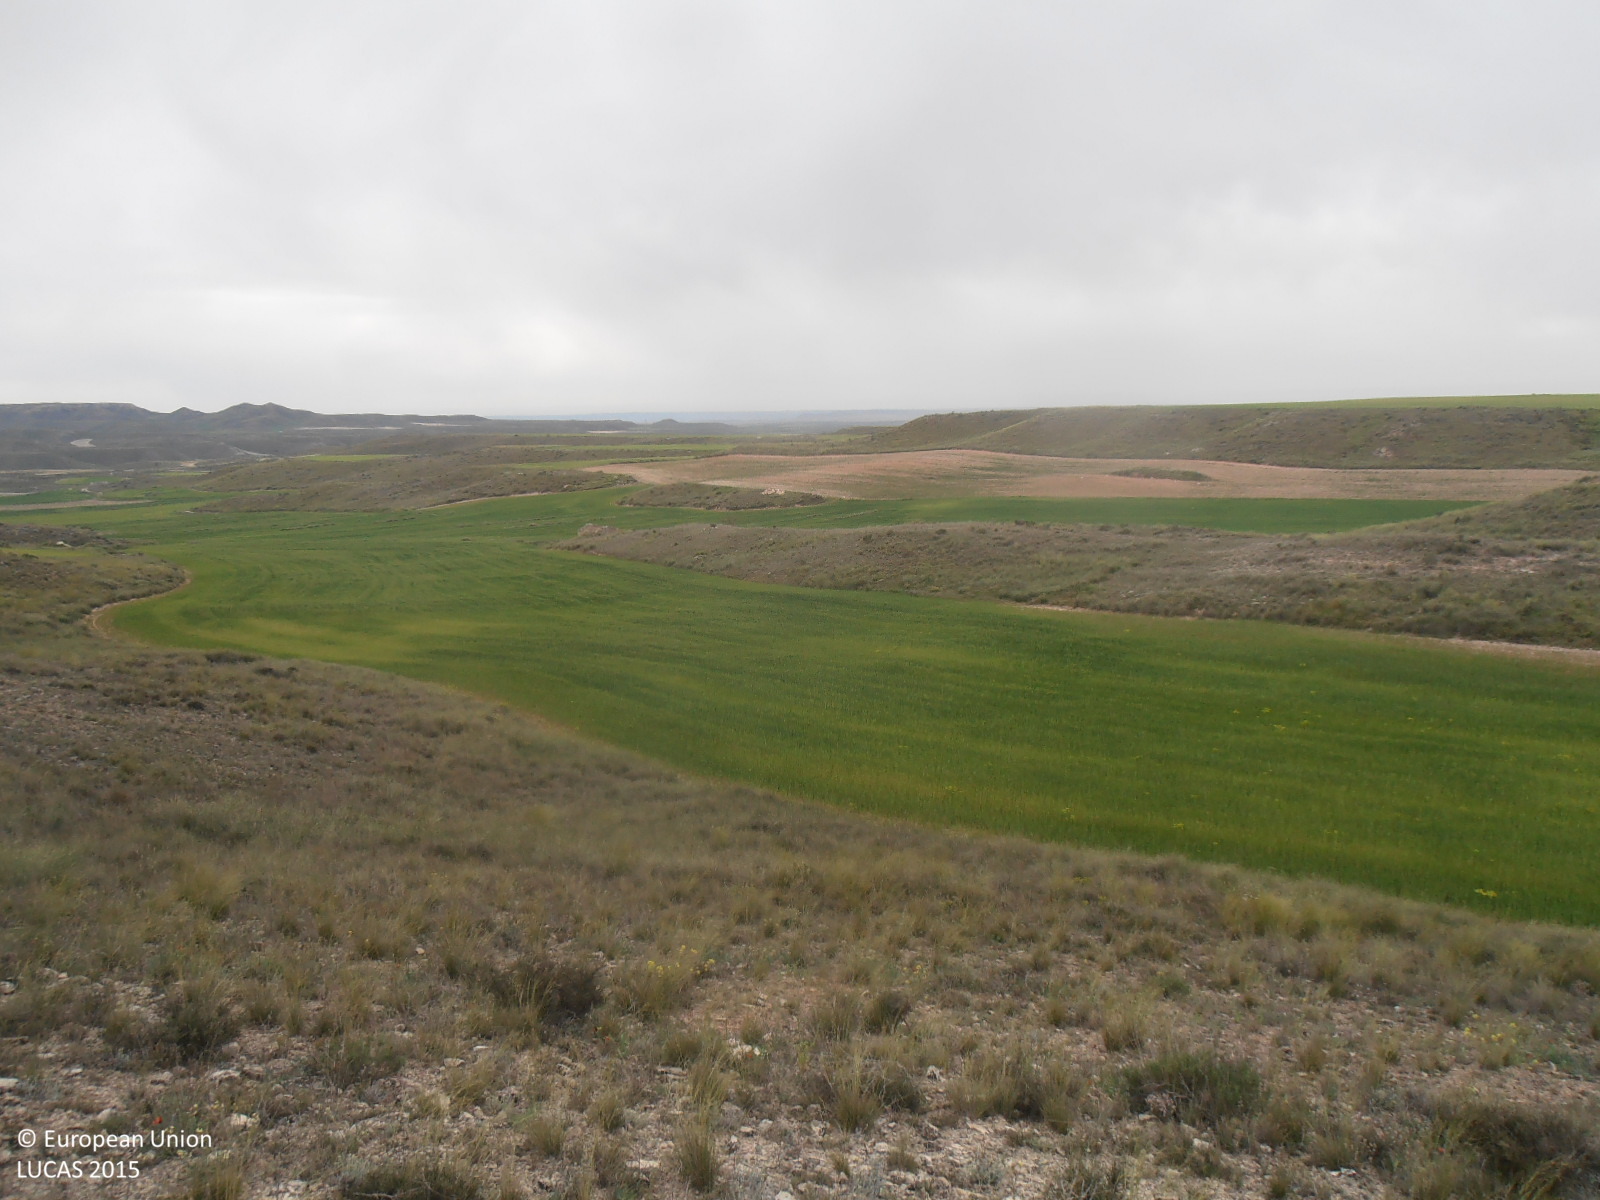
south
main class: Grassland
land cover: Grassland without tree/shrub cover
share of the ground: > 75 %
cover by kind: herbaceous plants 65 %, consolidated bare surface 30 %, shrubs 5 %
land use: Semi-natural and natural areas not in use
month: April
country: ES
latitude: 41.4087
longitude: -0.3878
